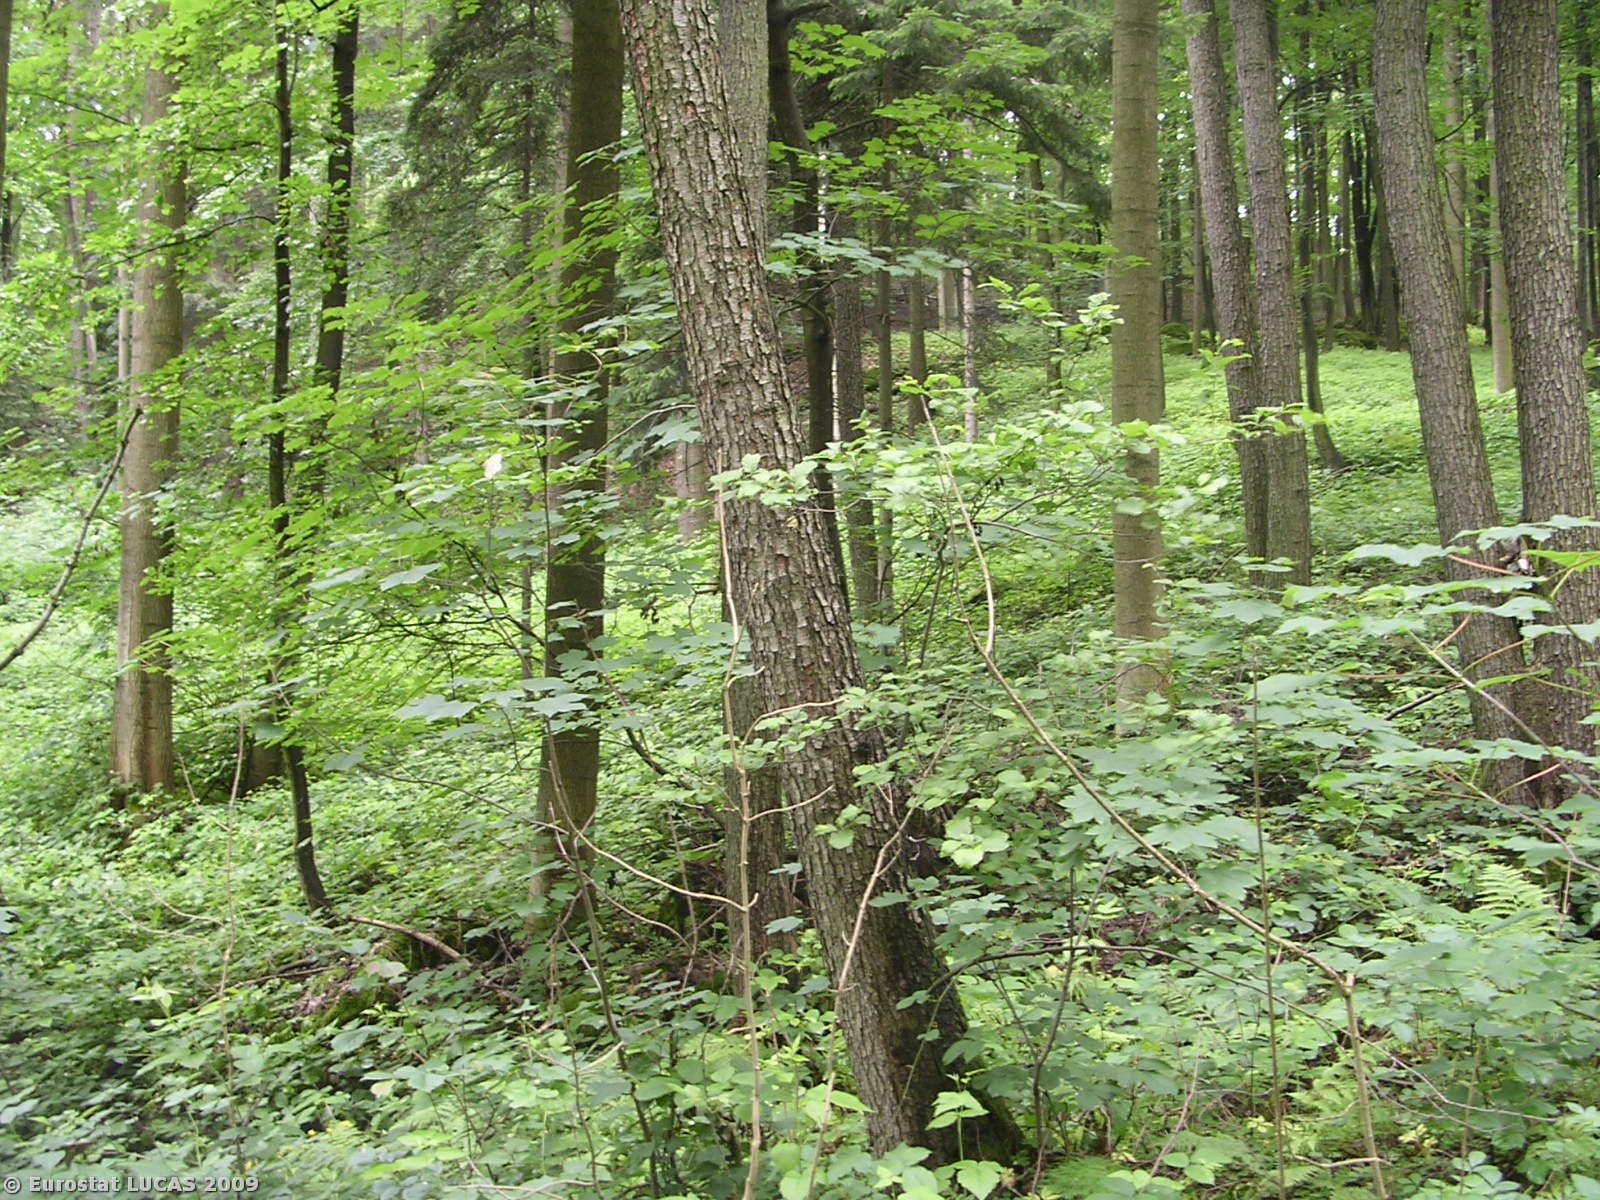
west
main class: Woodland
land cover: Mixed woodland
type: hemiboreal forest and nemoral coniferous forest and mixed broadleaved-coniferous forest
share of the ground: > 75 %
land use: Water supply and treatment
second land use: Forestry
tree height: > 5 m
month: June
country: CZ
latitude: 50.6069
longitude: 14.3112
